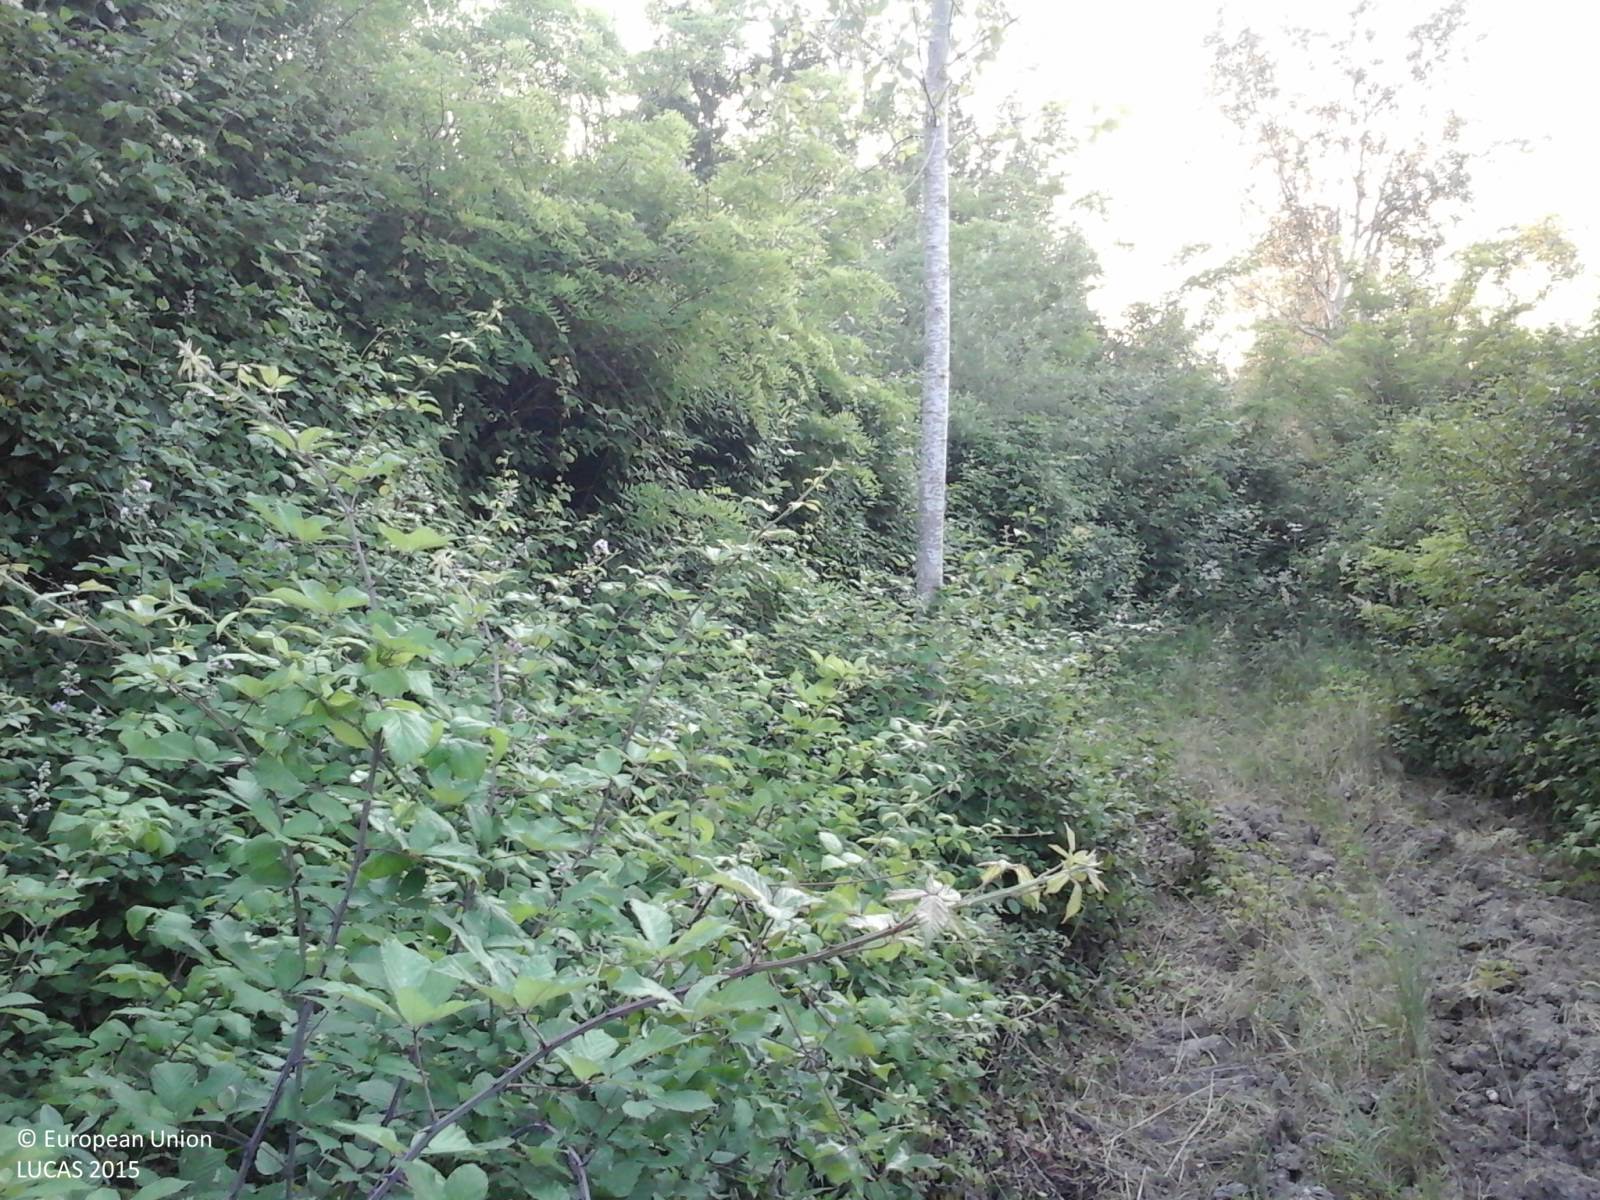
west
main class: Woodland
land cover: Broadleaved woodland
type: floodplain forest
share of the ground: > 75 %
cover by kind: broadleaved forest trees 65 %, shrubs 25 %, herbaceous plants 10 %
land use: Forestry
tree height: > 5 m
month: June
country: IT
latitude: 45.8828
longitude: 12.7668
